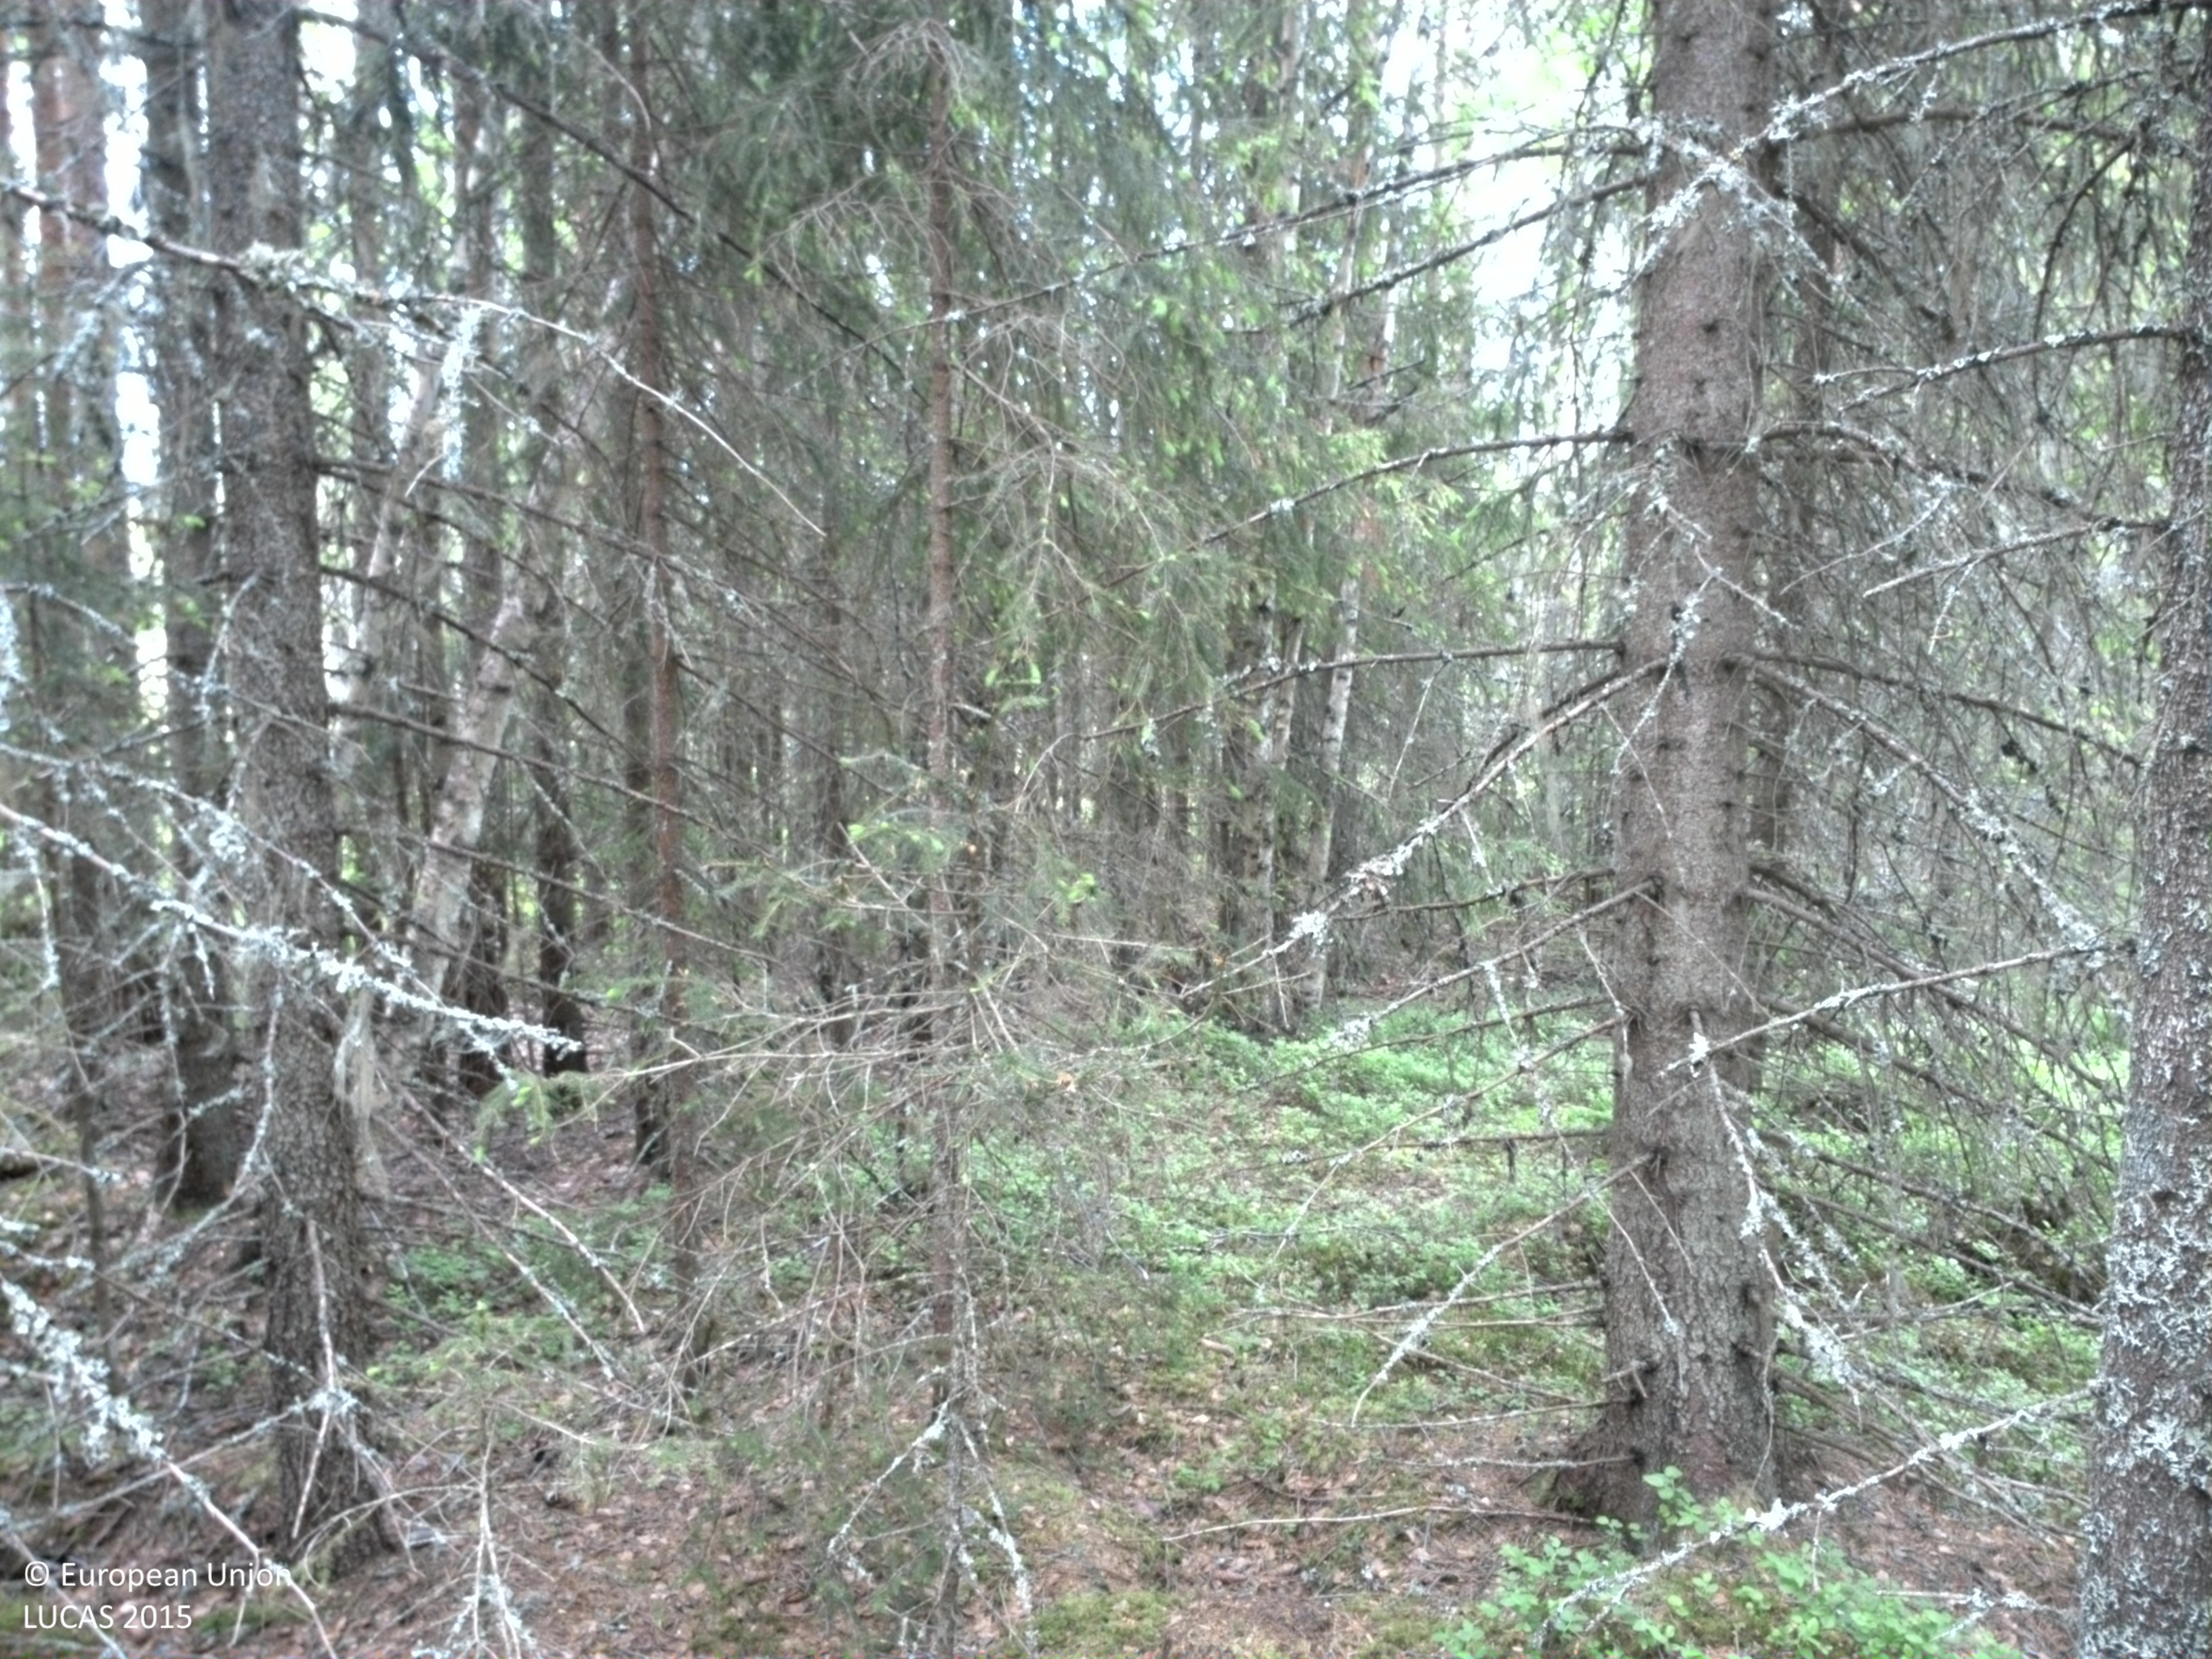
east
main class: Woodland
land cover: Spruce dominated coniferous woodland
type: boreal forest
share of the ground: > 75 %
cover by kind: coniferous forest trees 75 %, broadleaved forest trees 15 %, lichens and mosses 10 %
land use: Forestry
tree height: > 5 m
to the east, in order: Spruce dominated coniferous woodland; Ditches and canals; Spruce dominated coniferous woodland; Spruce dominated mixed woodland; Ditches and canals; Spruce dominated mixed woodland; Spruce dominated coniferous woodland; Peatbogs; Spruce dominated mixed woodland; Peatbogs; Spruce dominated coniferous woodland
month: June
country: SE
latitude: 61.1278
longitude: 13.5341
